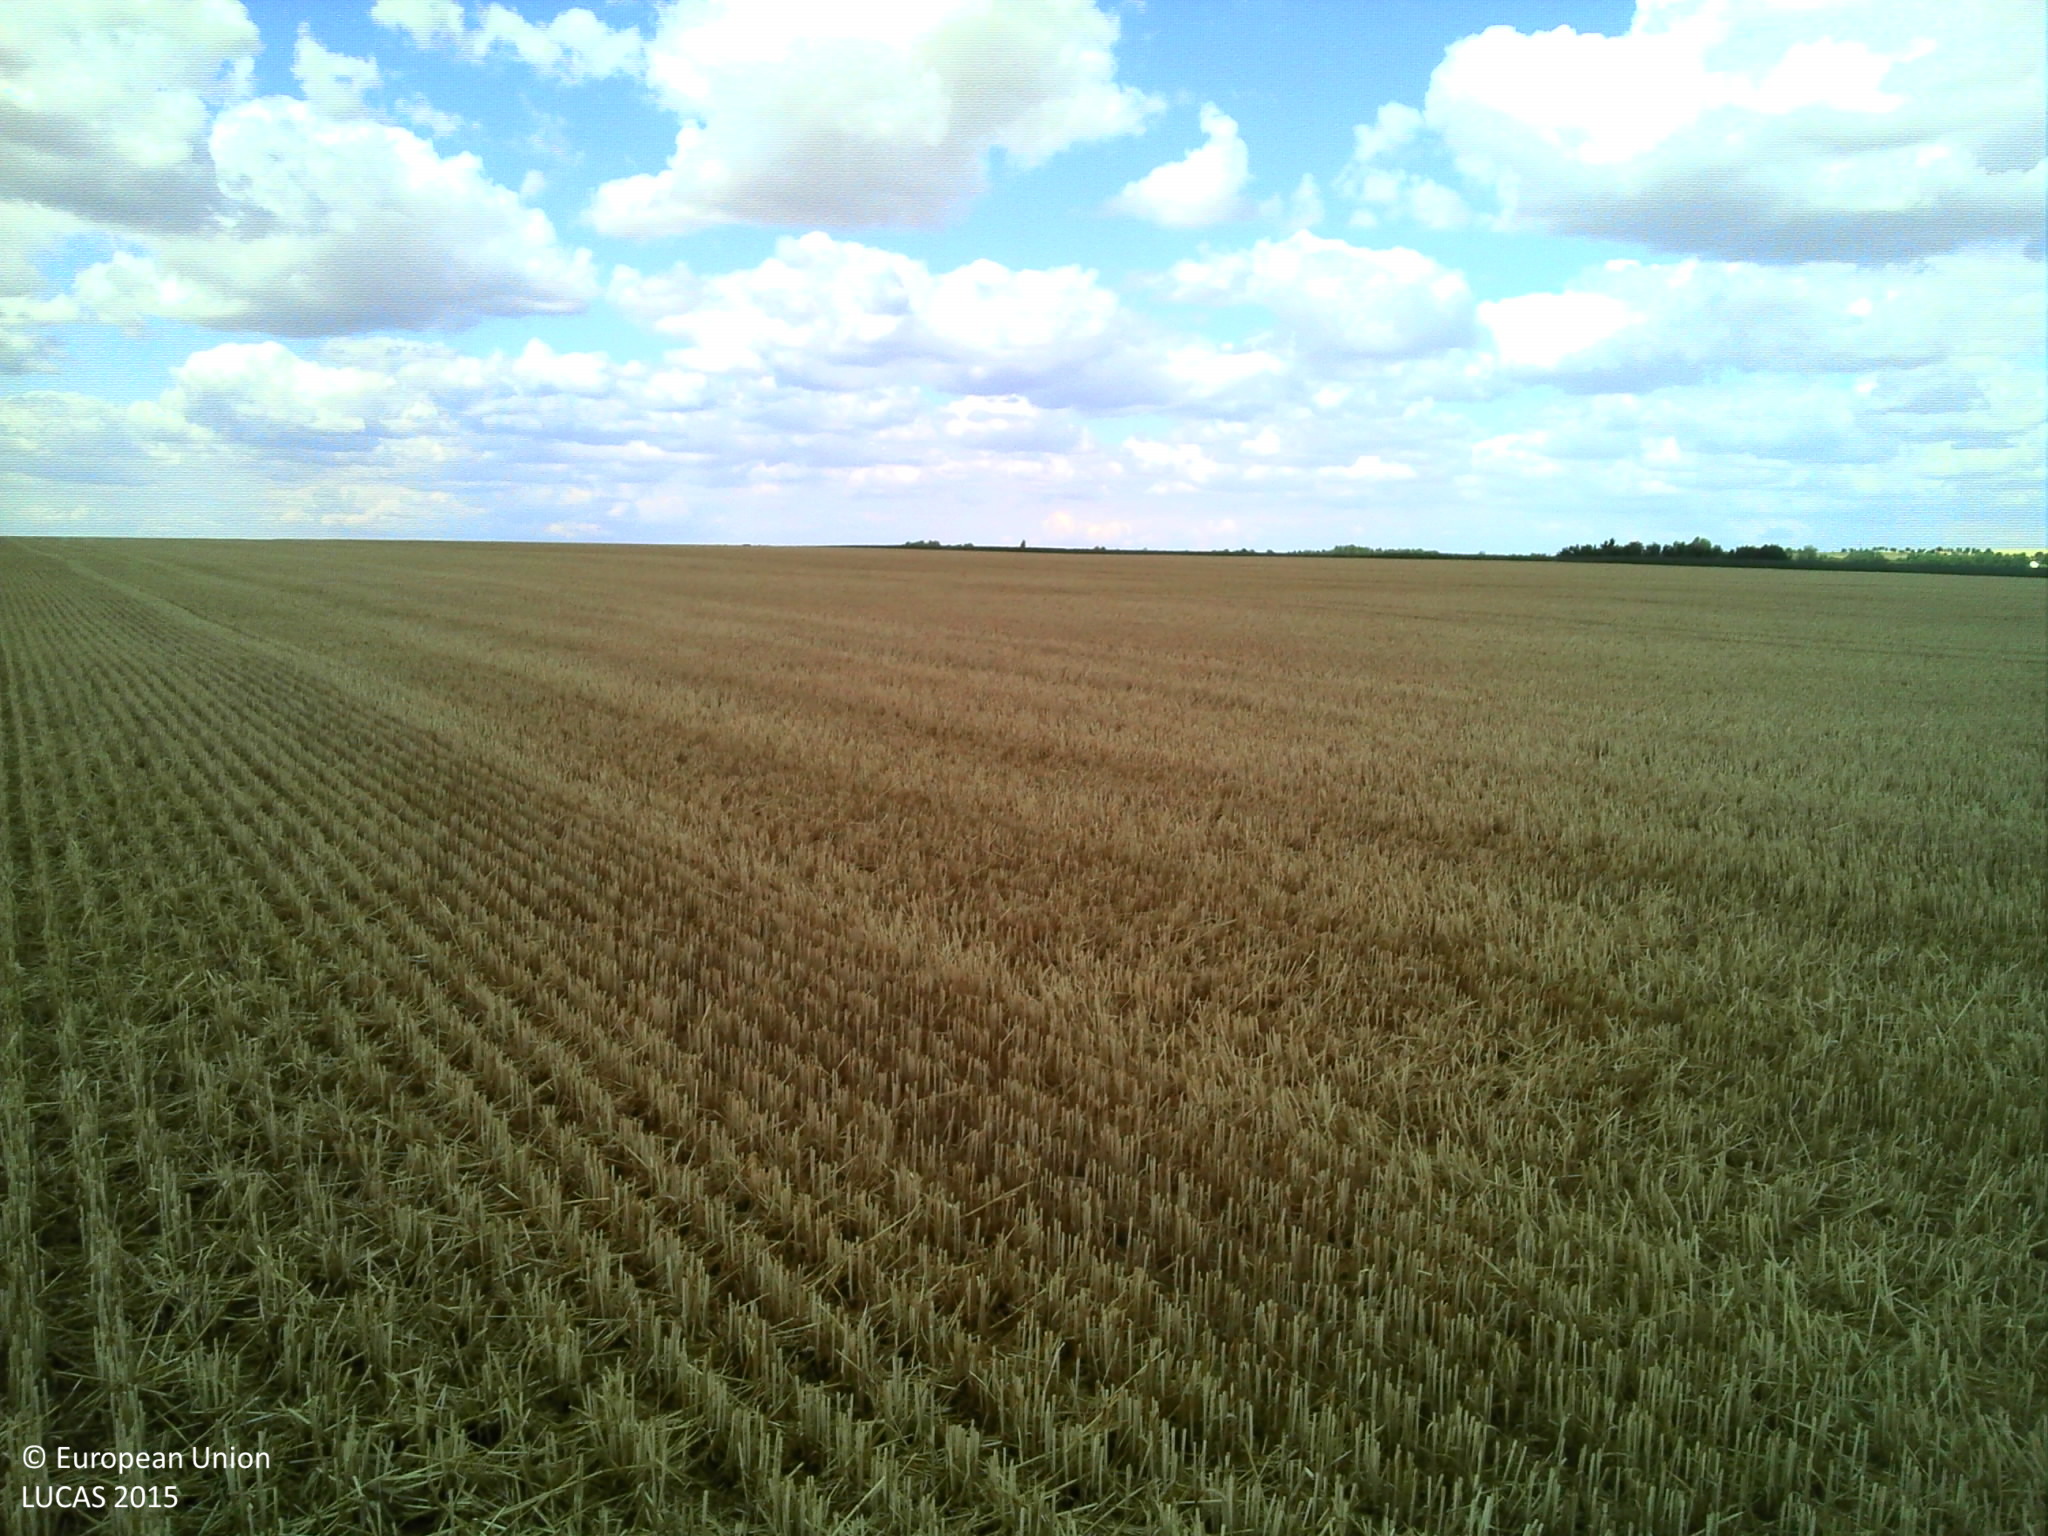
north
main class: Cropland
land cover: Common wheat
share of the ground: > 75 %
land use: Agriculture (excluding fallow land and kitchen gardens)
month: July
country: FR
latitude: 48.8783
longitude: 4.1187
